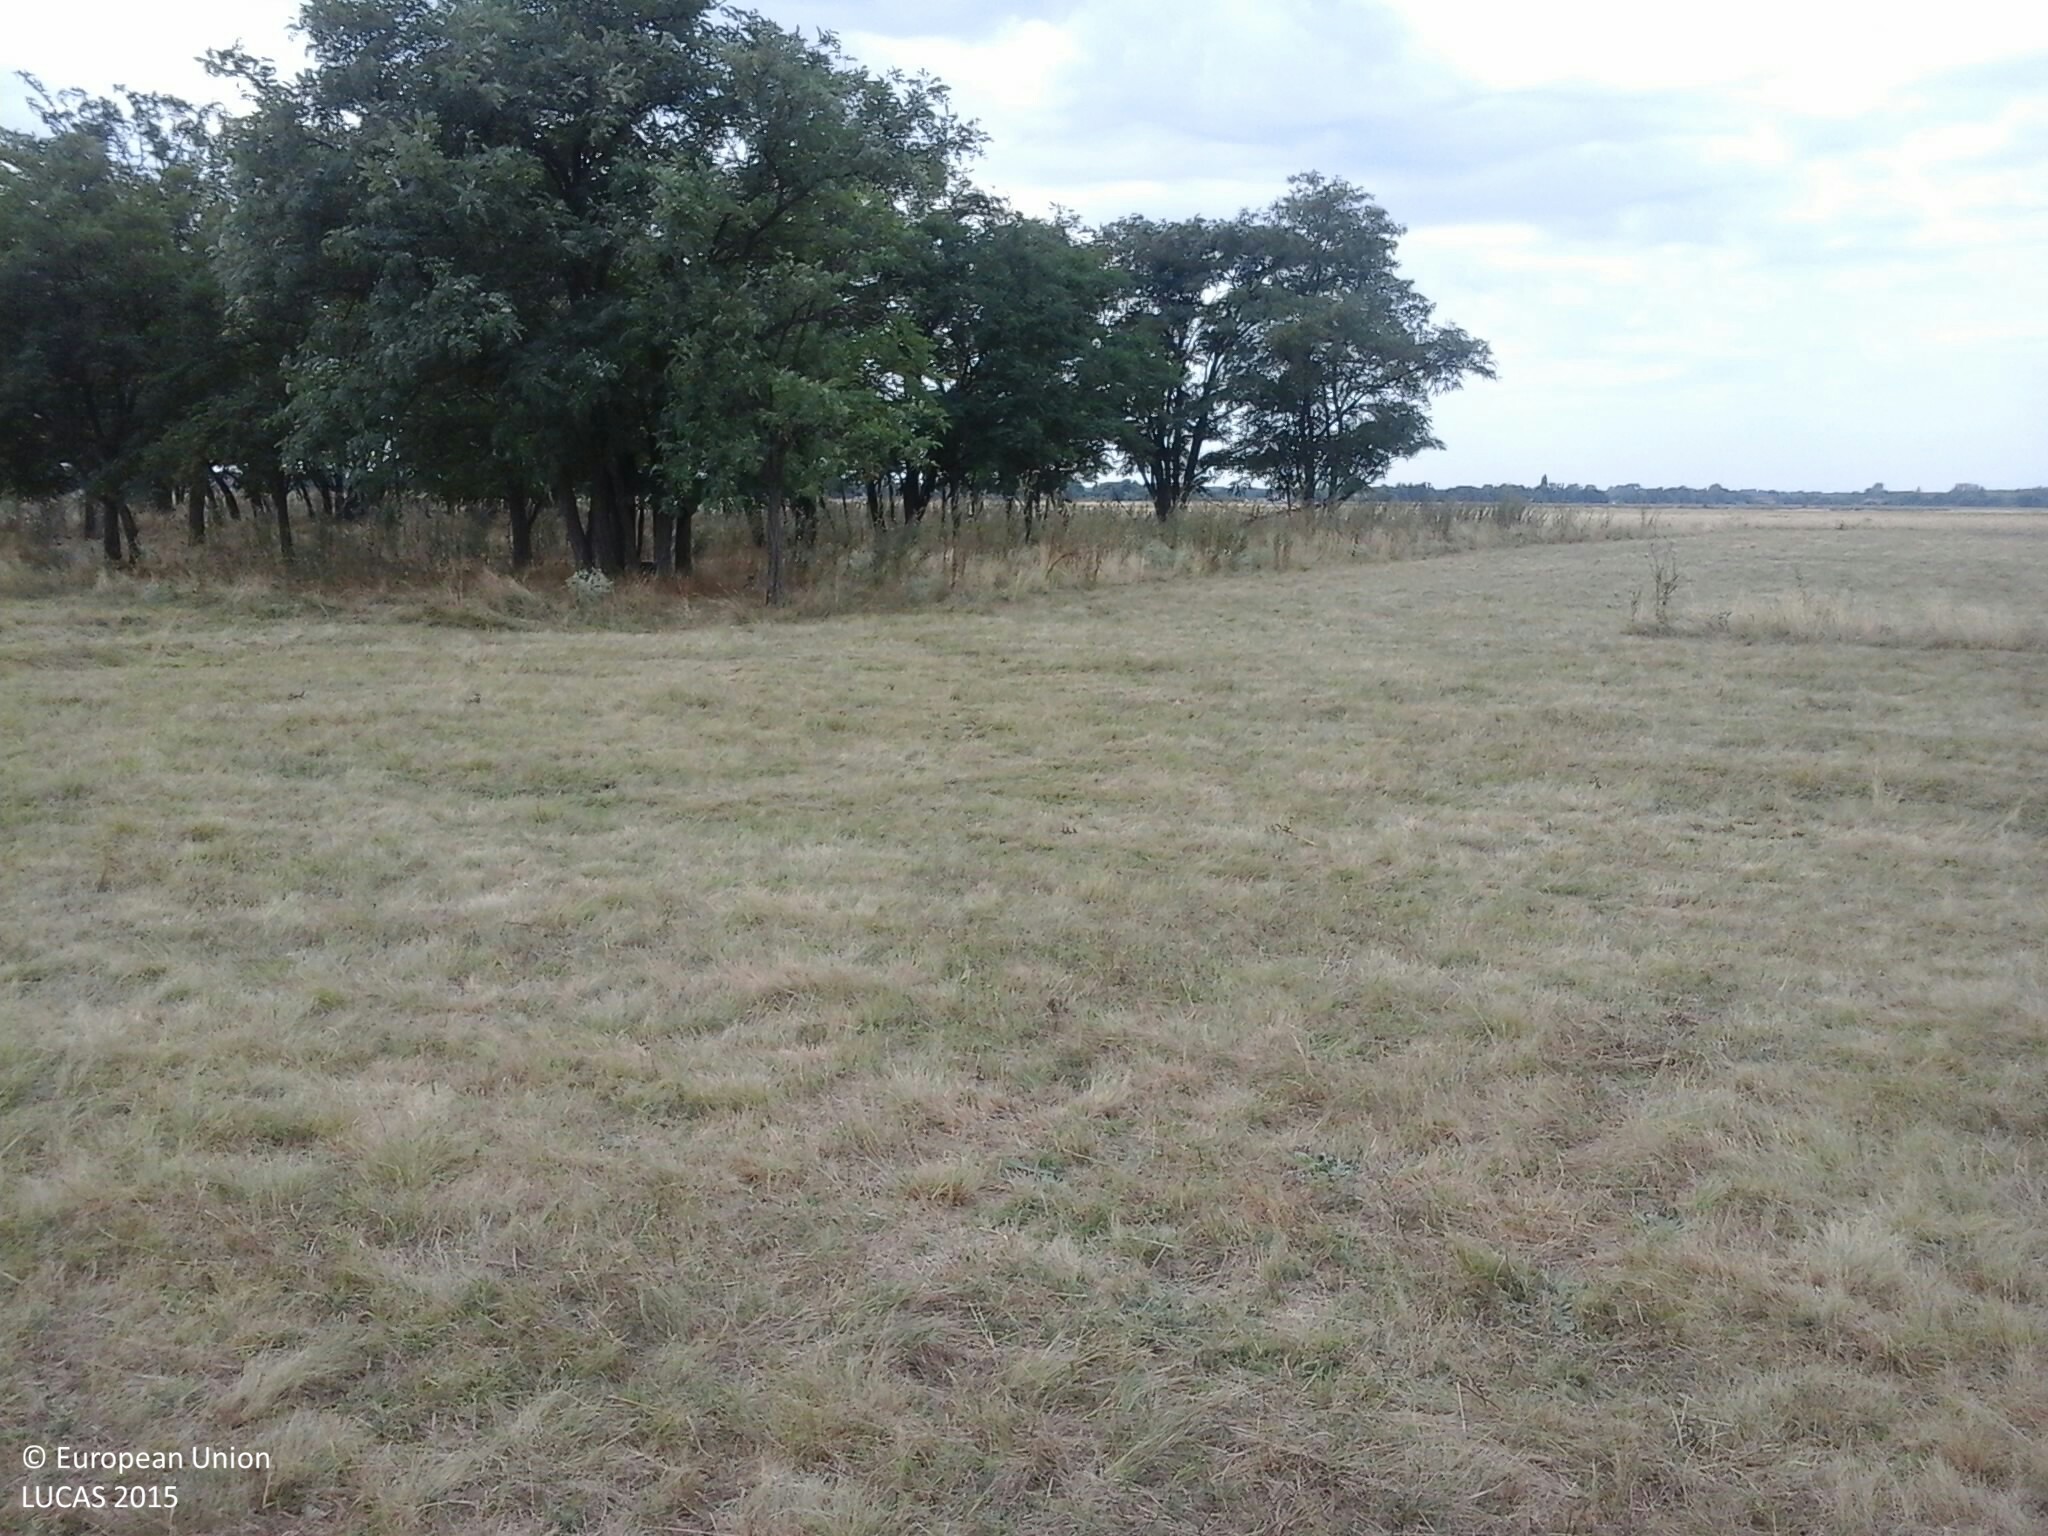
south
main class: Grassland
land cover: Grassland without tree/shrub cover
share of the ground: > 75 %
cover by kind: herbaceous plants 100 %
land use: Agriculture (excluding fallow land and kitchen gardens)
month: July
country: HU
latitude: 46.5276
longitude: 20.0739
